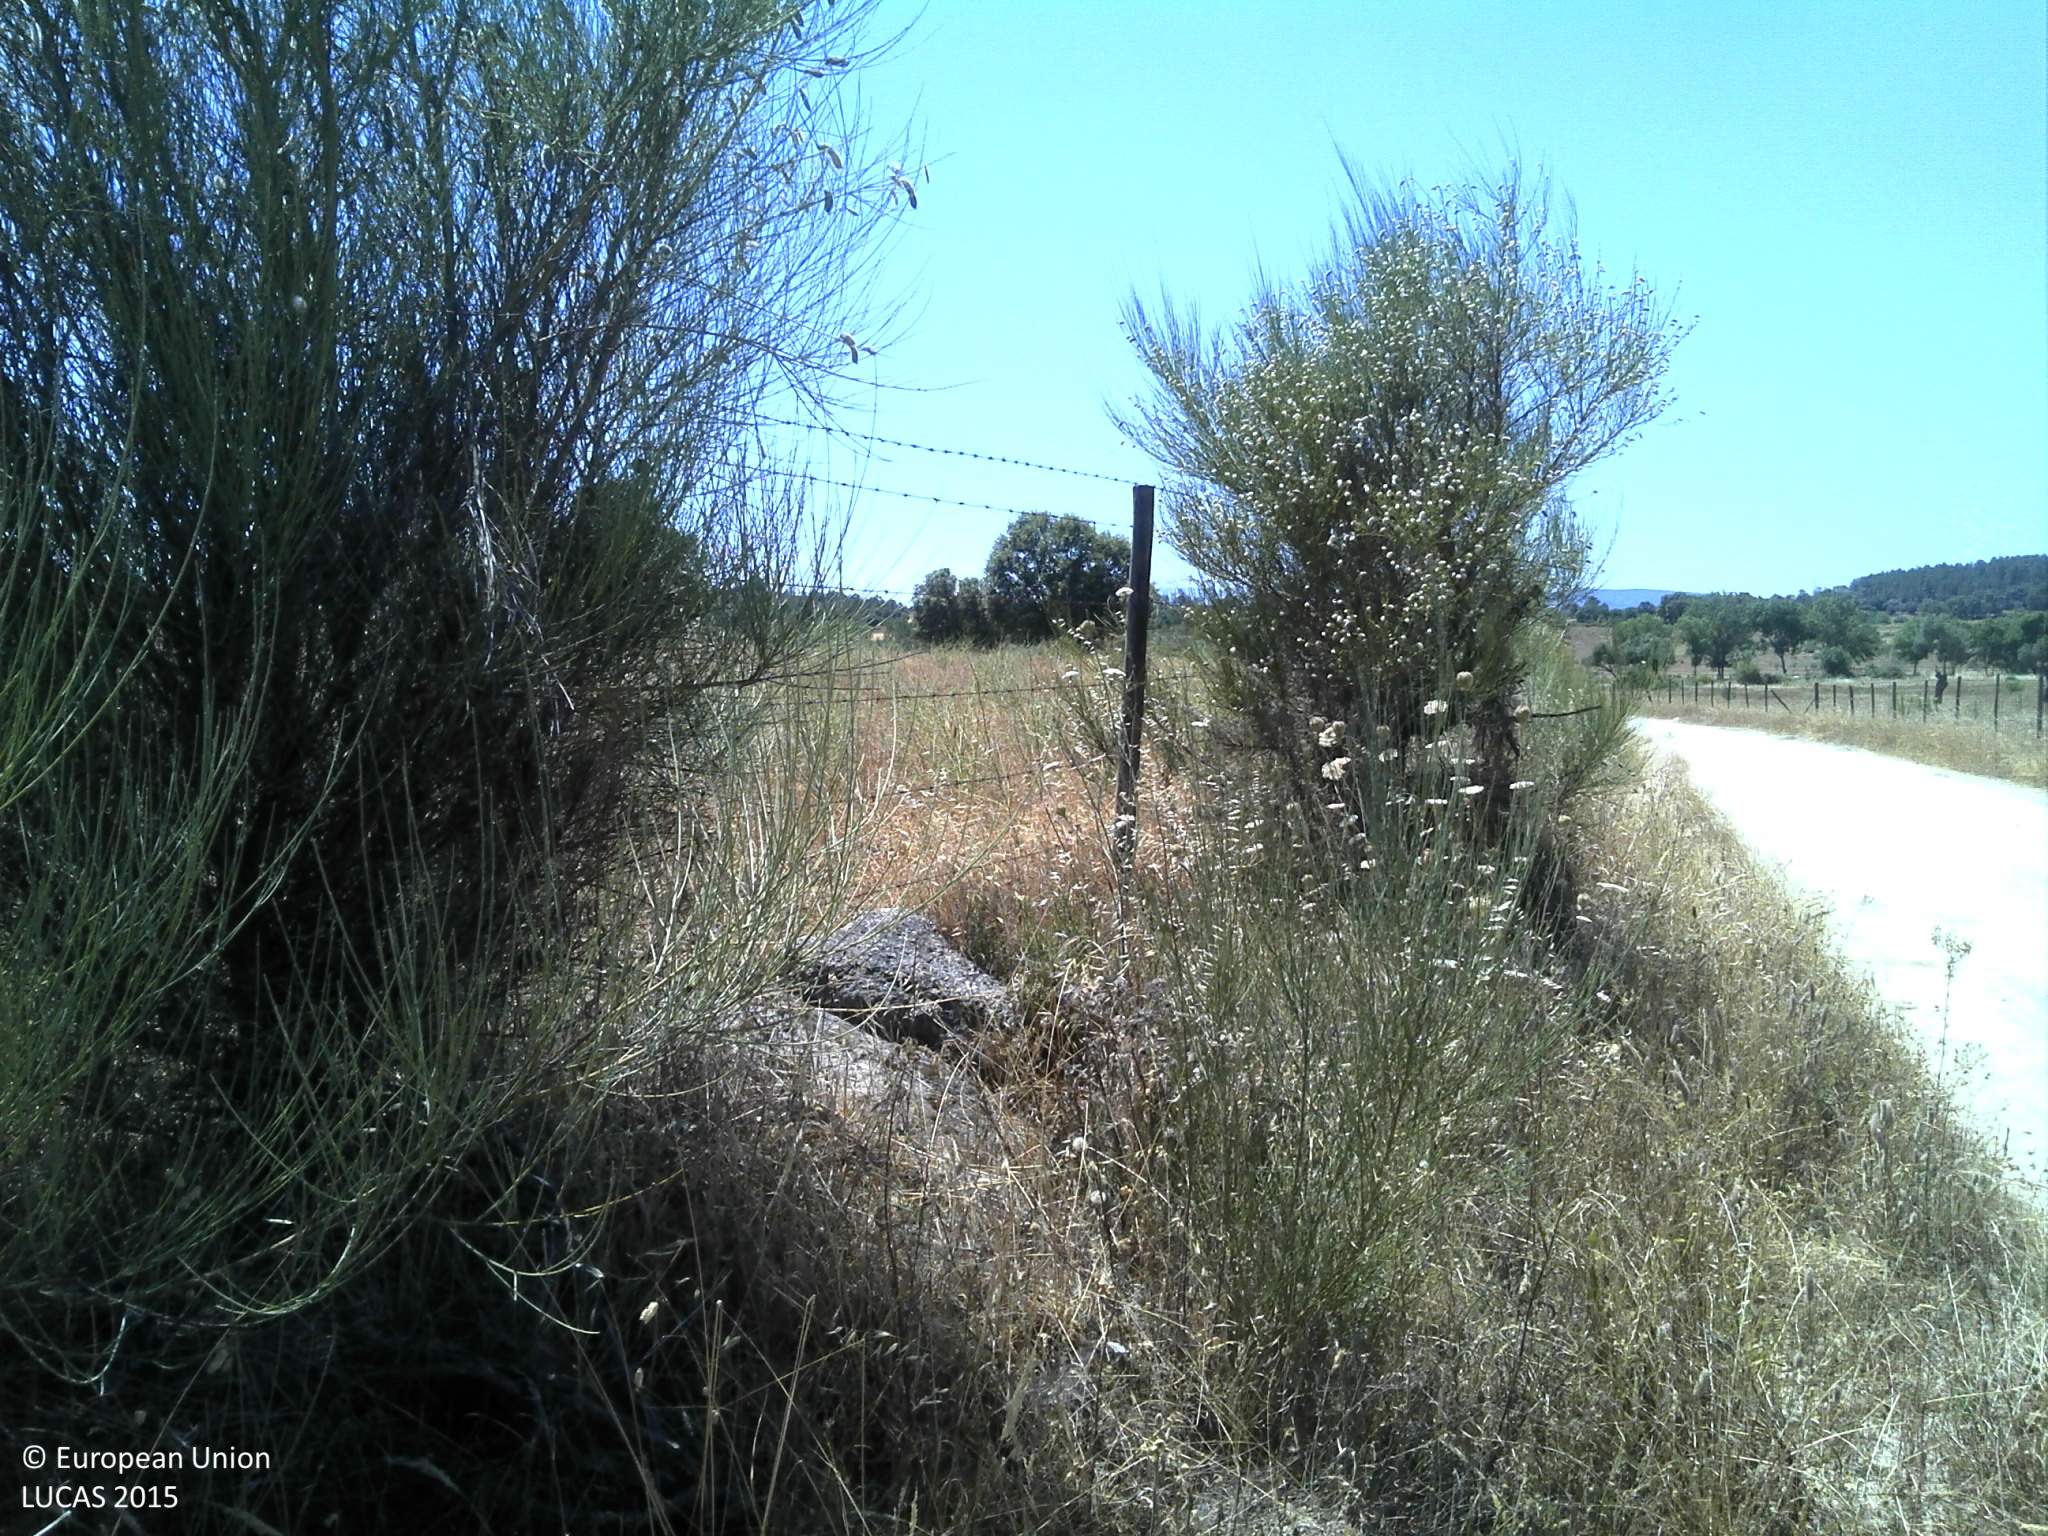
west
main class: Grassland
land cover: Grassland without tree/shrub cover
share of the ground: 50 - 75 %
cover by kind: herbaceous plants 65 %, unconsolidated bare surface 30 %
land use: Agriculture (excluding fallow land and kitchen gardens)
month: June
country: PT
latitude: 40.1119
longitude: -7.2391
